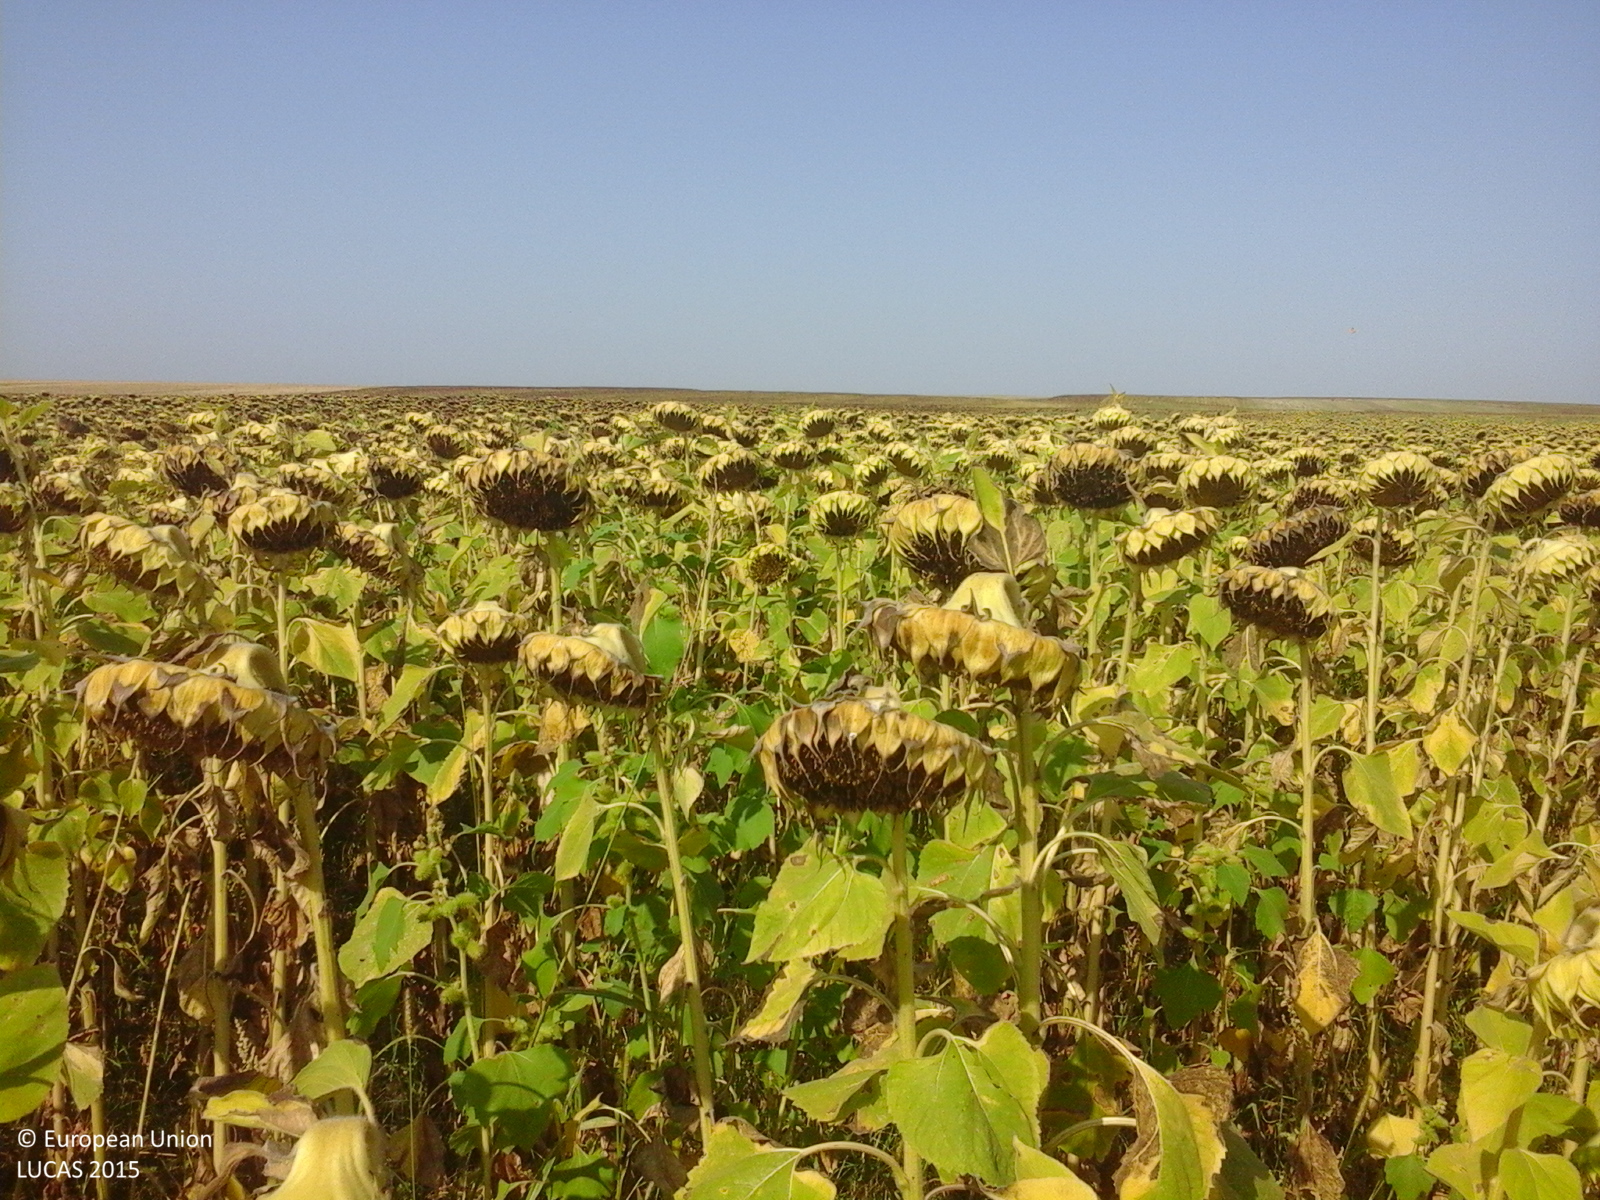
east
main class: Cropland
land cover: Sunflower
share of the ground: > 75 %
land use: Agriculture (excluding fallow land and kitchen gardens)
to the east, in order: Sunflower; Shruby margins; Tracks; Grassland without tree/shrub cover; Tracks; Grassland without tree/shrub cover
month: August
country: RO
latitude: 44.1314
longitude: 23.2827
